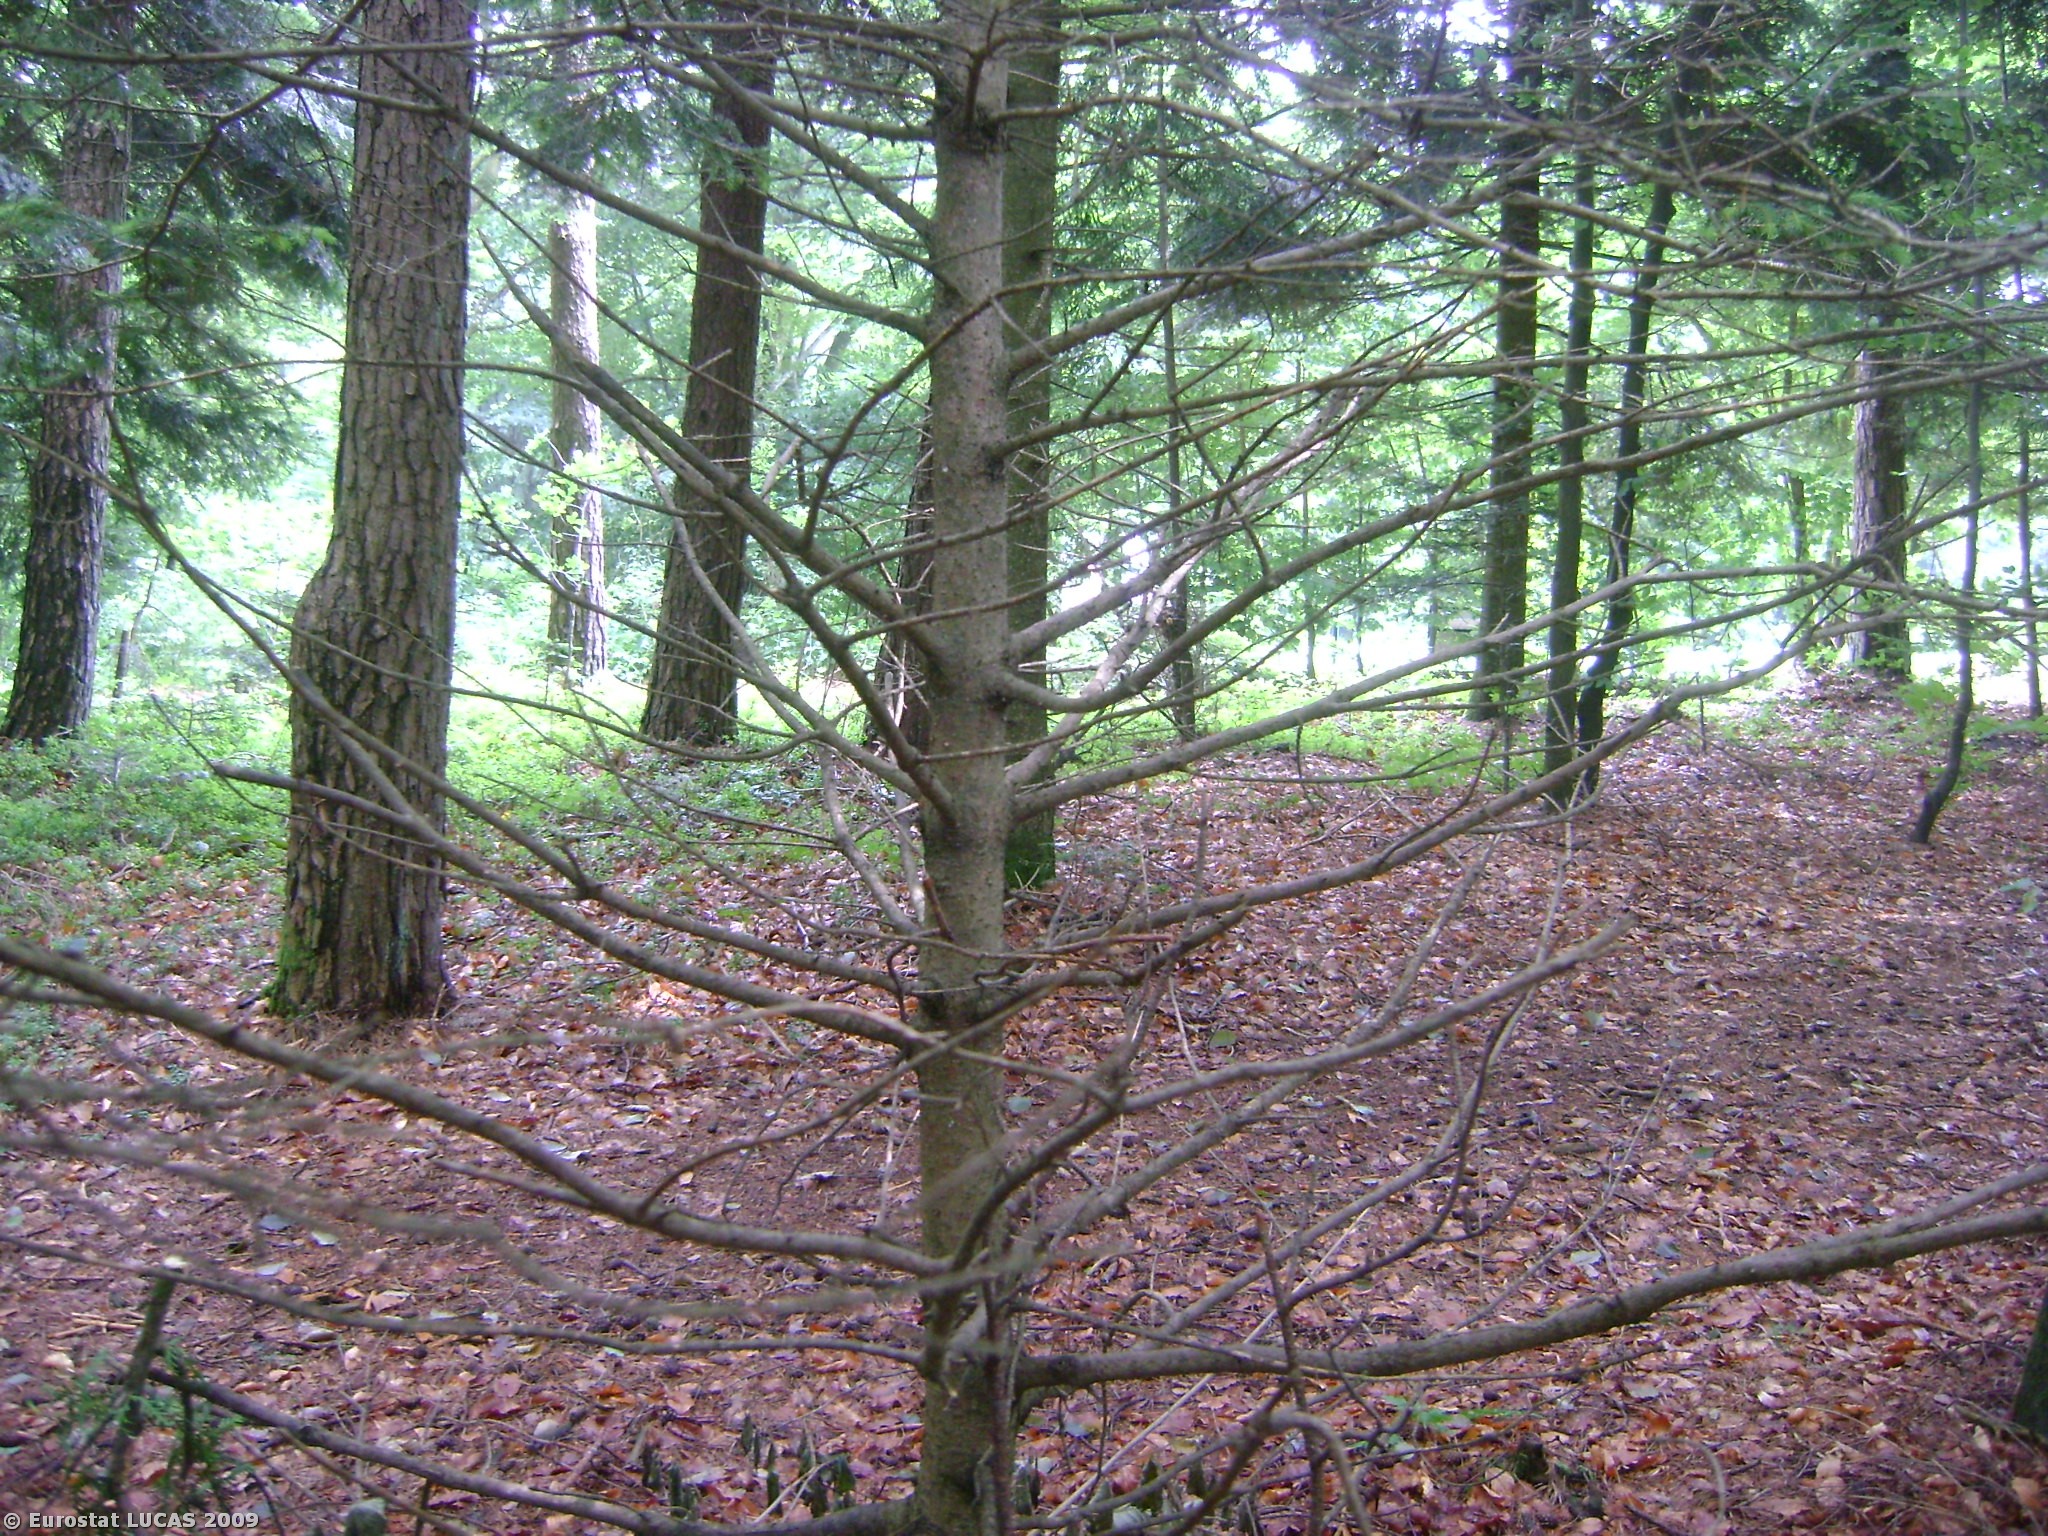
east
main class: Woodland
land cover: Mixed woodland
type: hemiboreal forest and nemoral coniferous forest and mixed broadleaved-coniferous forest
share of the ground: > 75 %
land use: Forestry
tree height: > 5 m
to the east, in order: Mixed woodland; Paved roads, cycling and walking lanes; Shrubland with sparse tree cover; Coniferous woodland; Grassland without tree/shrub cover; Shrubland with sparse tree cover; Broadleaved woodland; Paved roads, cycling and walking lanes; Broadleaved woodland; Tracks; Broadleaved woodland; Grassland without tree/shrub cover
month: June
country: AT
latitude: 48.1392
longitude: 13.2647
